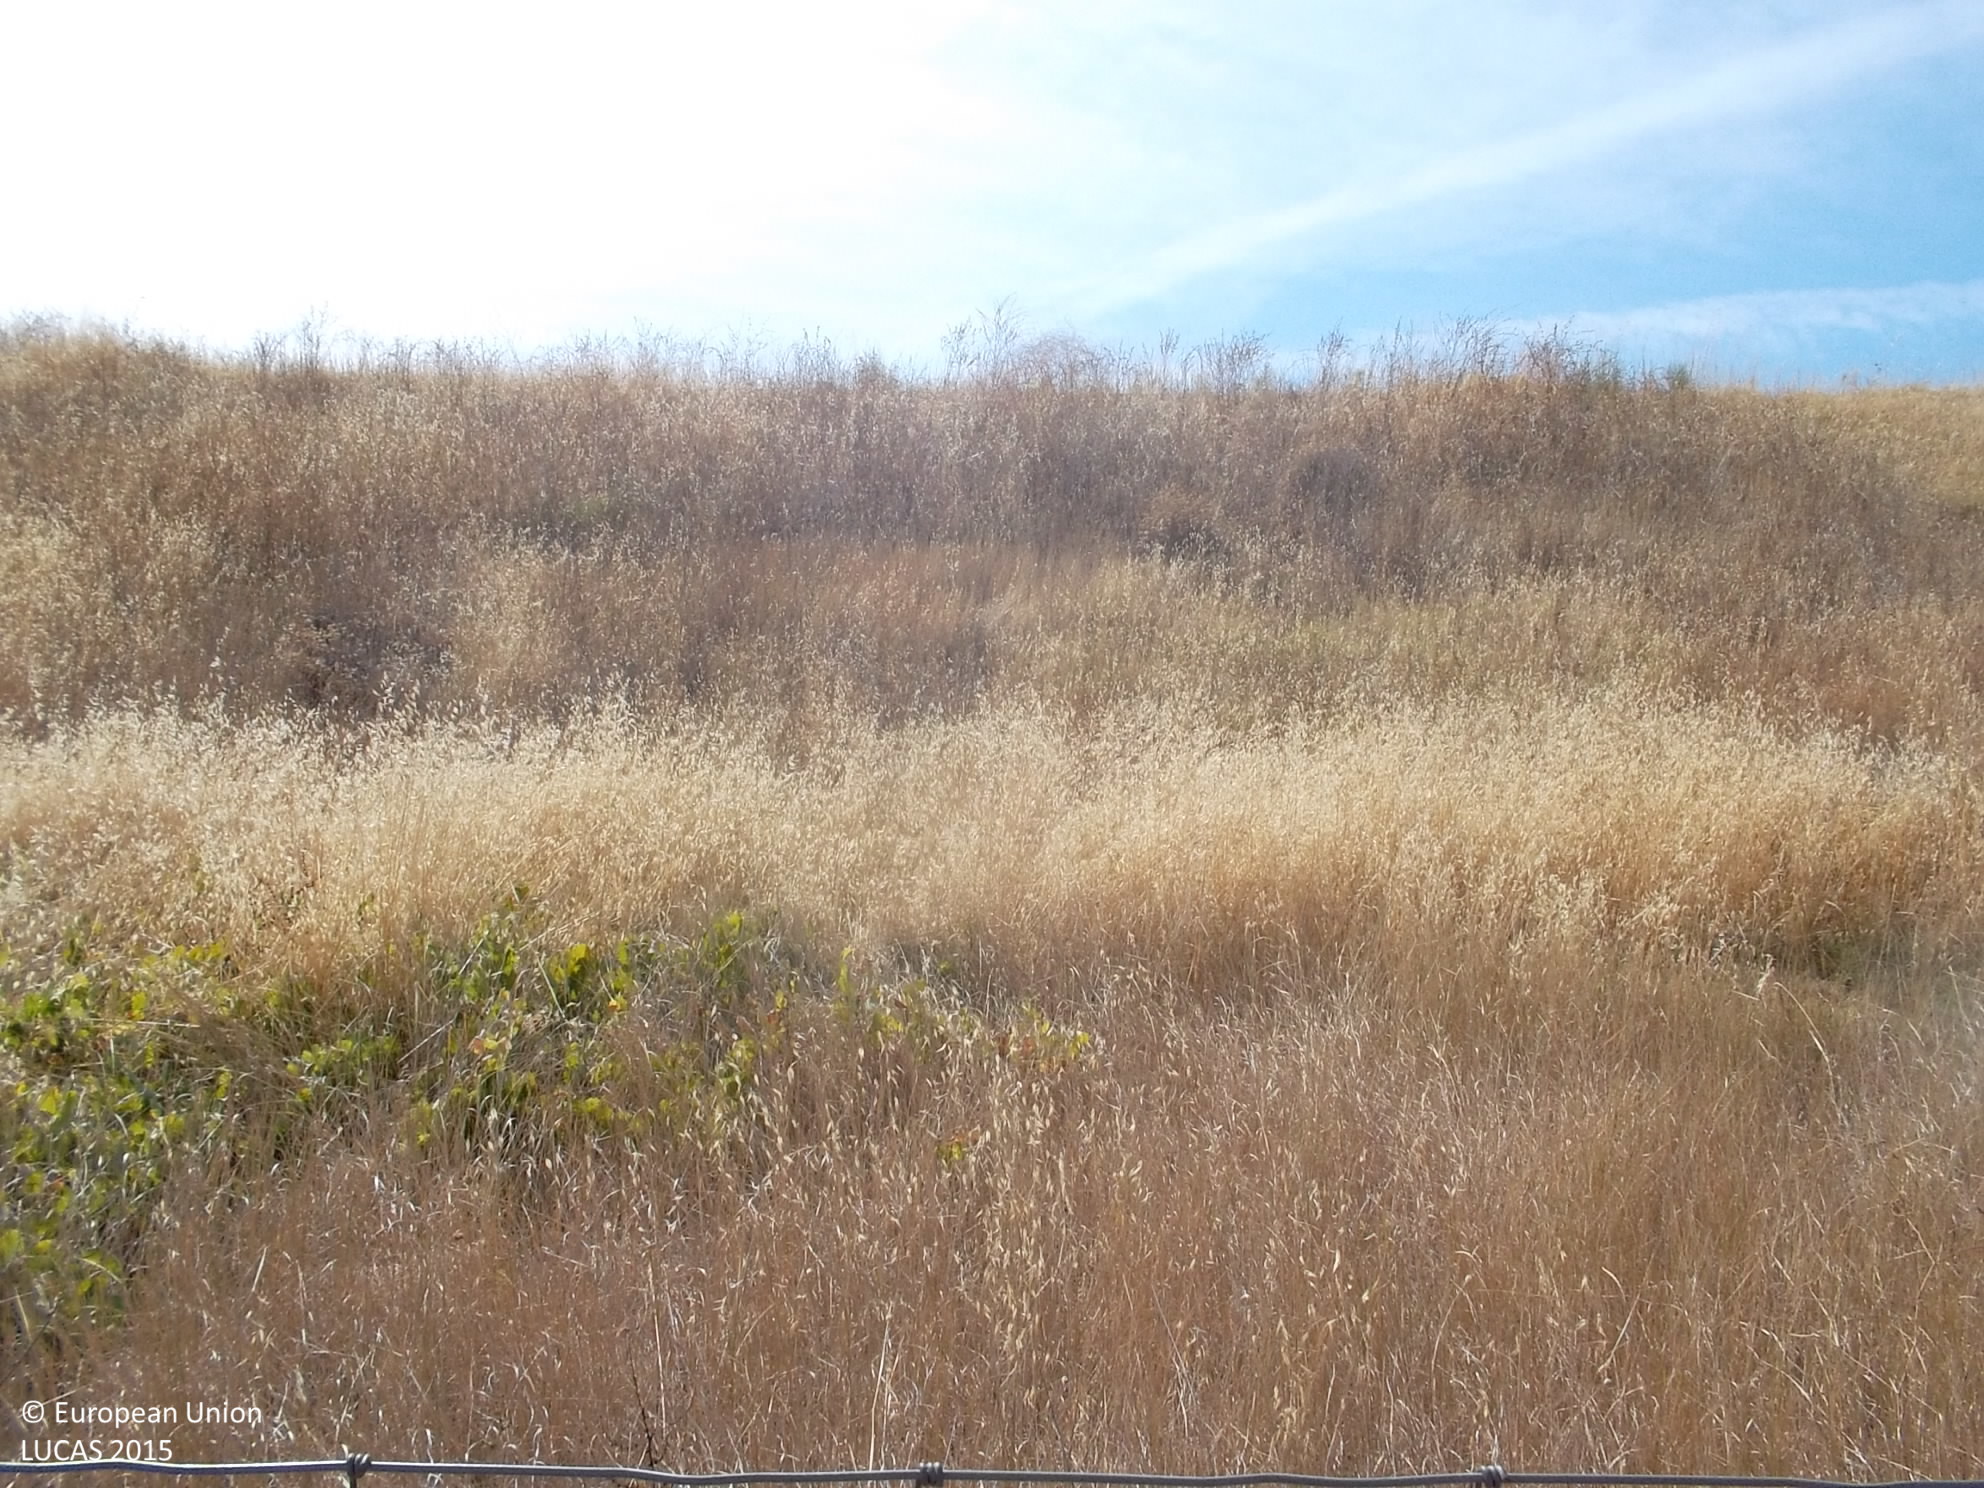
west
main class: Grassland
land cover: Grassland without tree/shrub cover
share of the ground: > 75 %
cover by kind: herbaceous plants 100 %
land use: Road transport
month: September
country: ES
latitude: 38.3895
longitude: -6.3400
